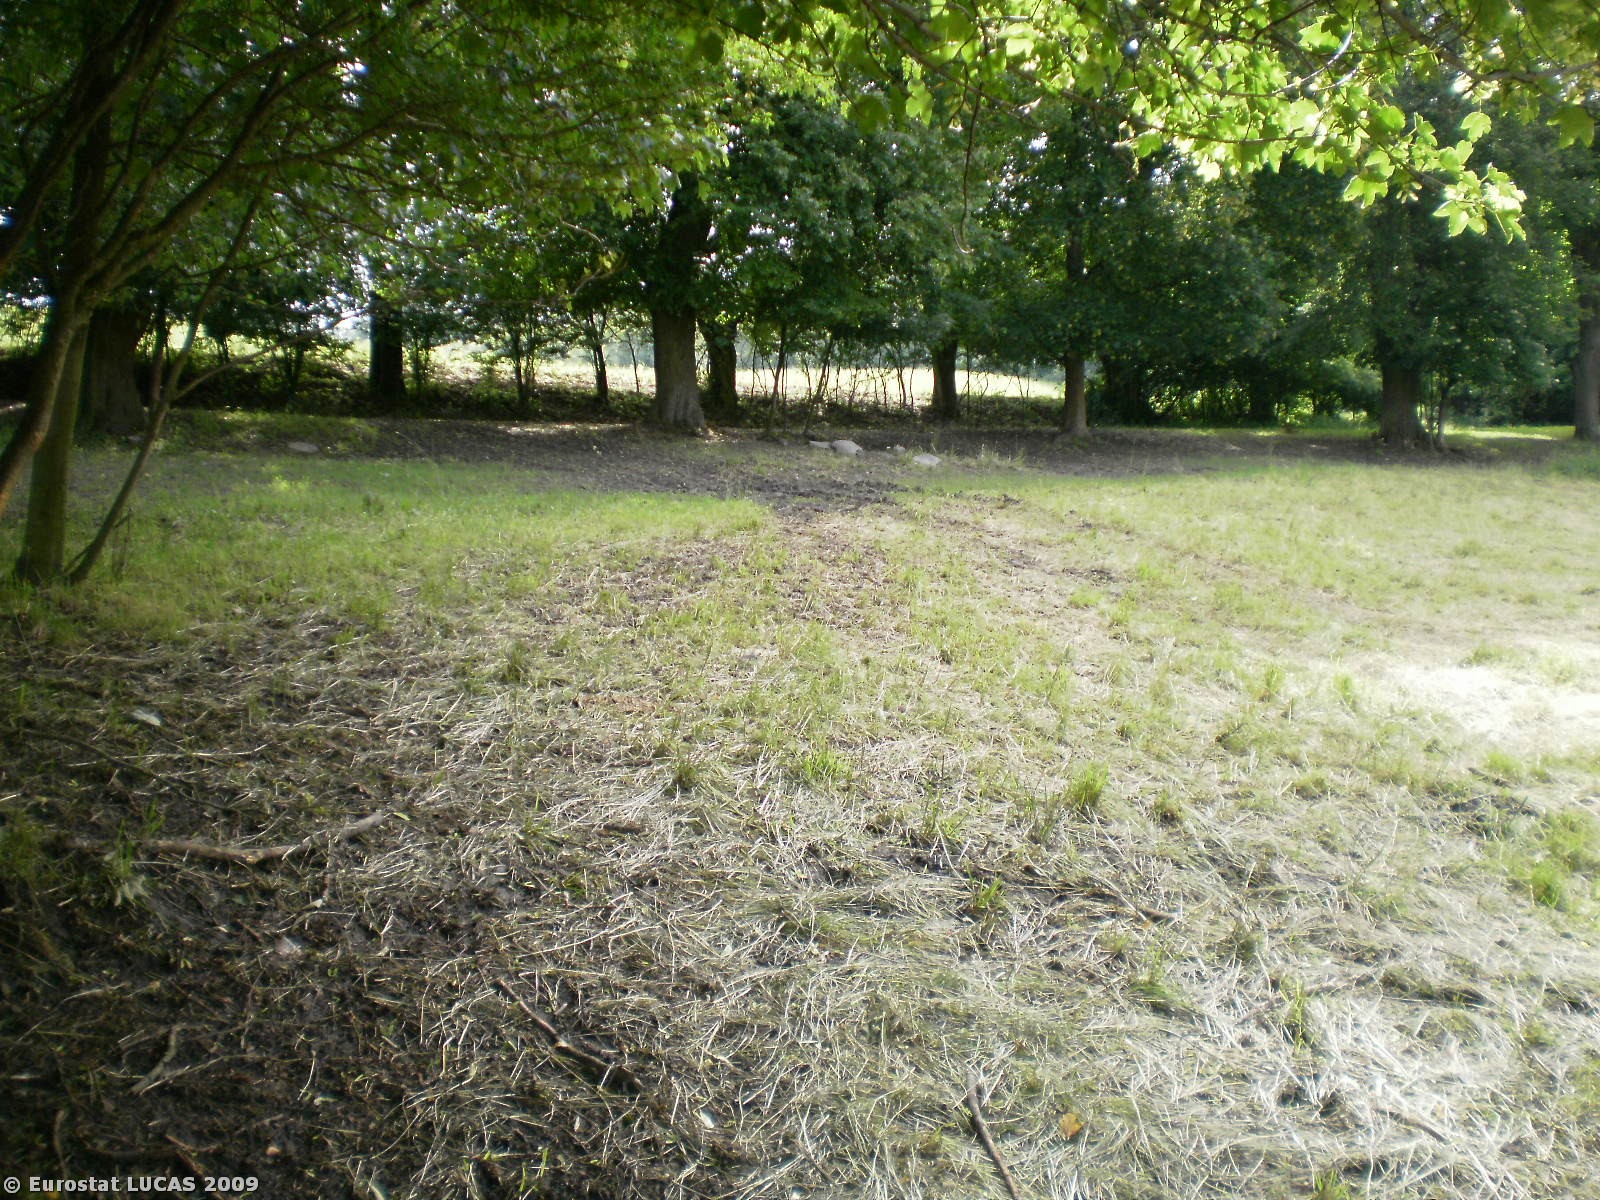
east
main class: Grassland
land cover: Grassland with sparse tree/shrub cover
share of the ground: > 75 %
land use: Agriculture (excluding fallow land and kitchen gardens)
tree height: > 5 m
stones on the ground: < 10 %
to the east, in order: Grassland with sparse tree/shrub cover; Grassland without tree/shrub cover; Lines of trees; Tracks; Lines of trees; Grassland without tree/shrub cover; Shrubland with sparse tree cover
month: June
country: PL
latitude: 53.5579
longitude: 19.8882
